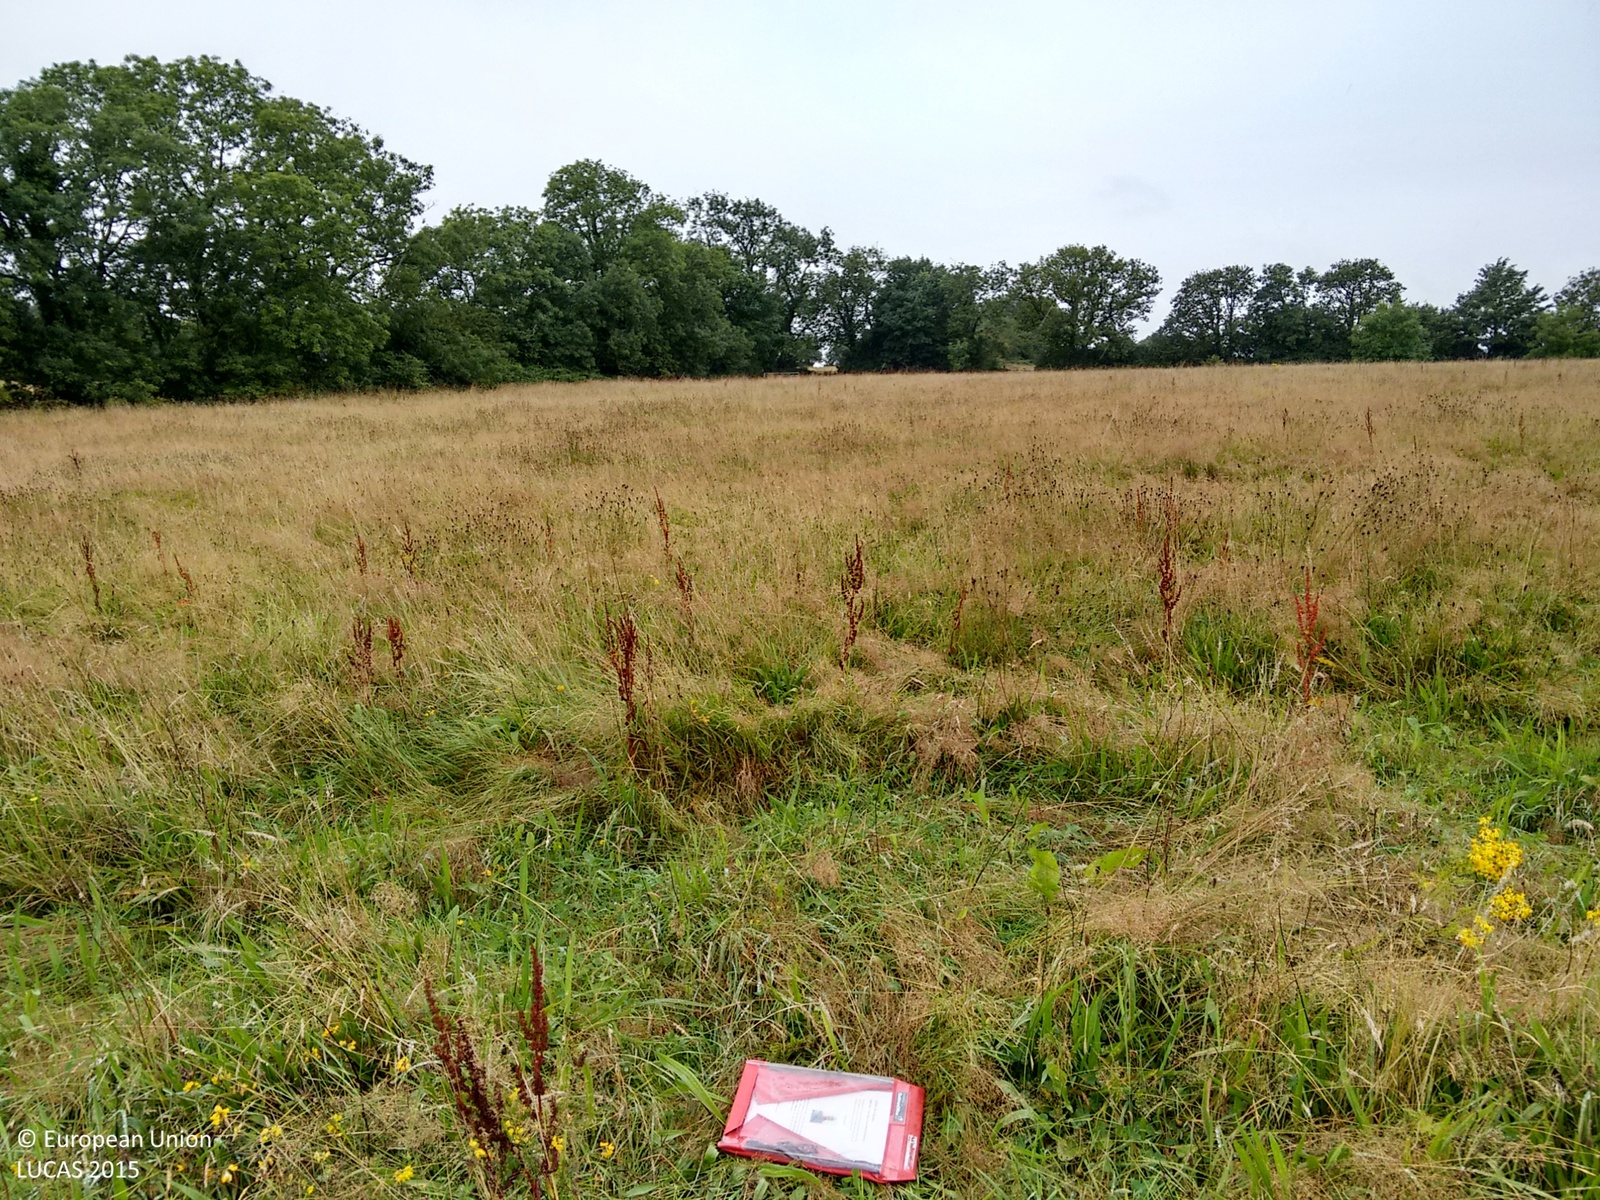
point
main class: Grassland
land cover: Grassland without tree/shrub cover
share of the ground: > 75 %
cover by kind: herbaceous plants 100 %
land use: Agriculture (excluding fallow land and kitchen gardens)
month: August
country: GB
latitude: 51.8218
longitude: -4.8391
